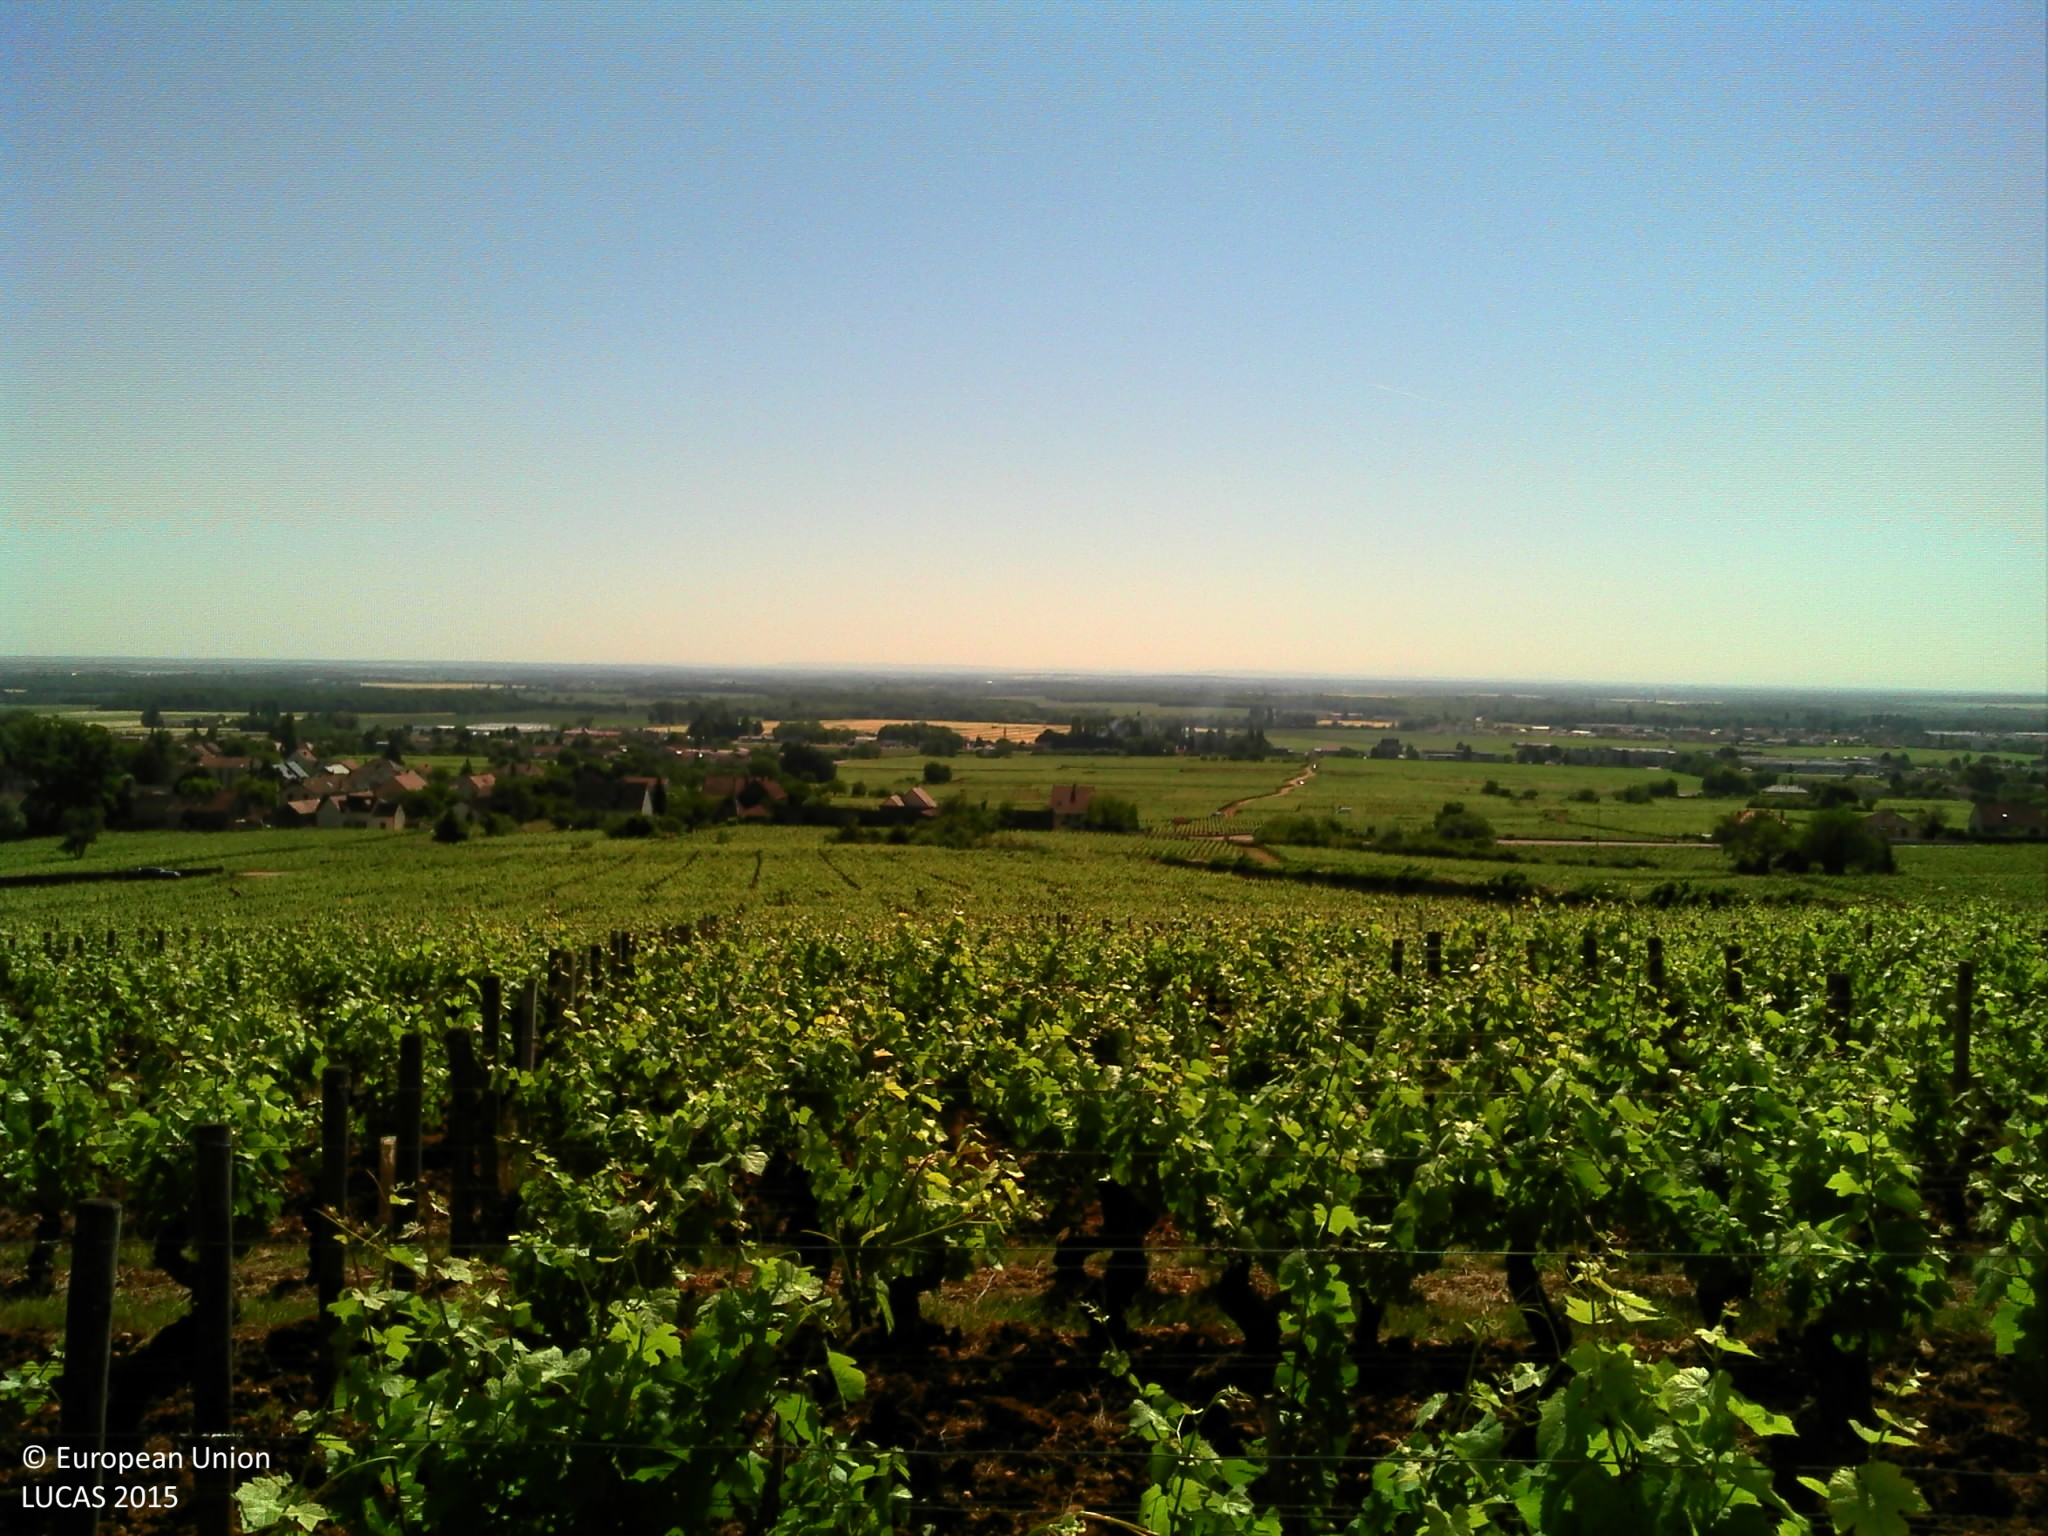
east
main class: Cropland
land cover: Vineyards
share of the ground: < 10 %
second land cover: Other bare soil
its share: > 75 %
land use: Agriculture (excluding fallow land and kitchen gardens)
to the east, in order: Vineyards; Other bare soil; Dry stone walls; Vineyards; Grass margins; Tracks; Vineyards
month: June
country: FR
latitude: 47.2431
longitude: 4.9671
